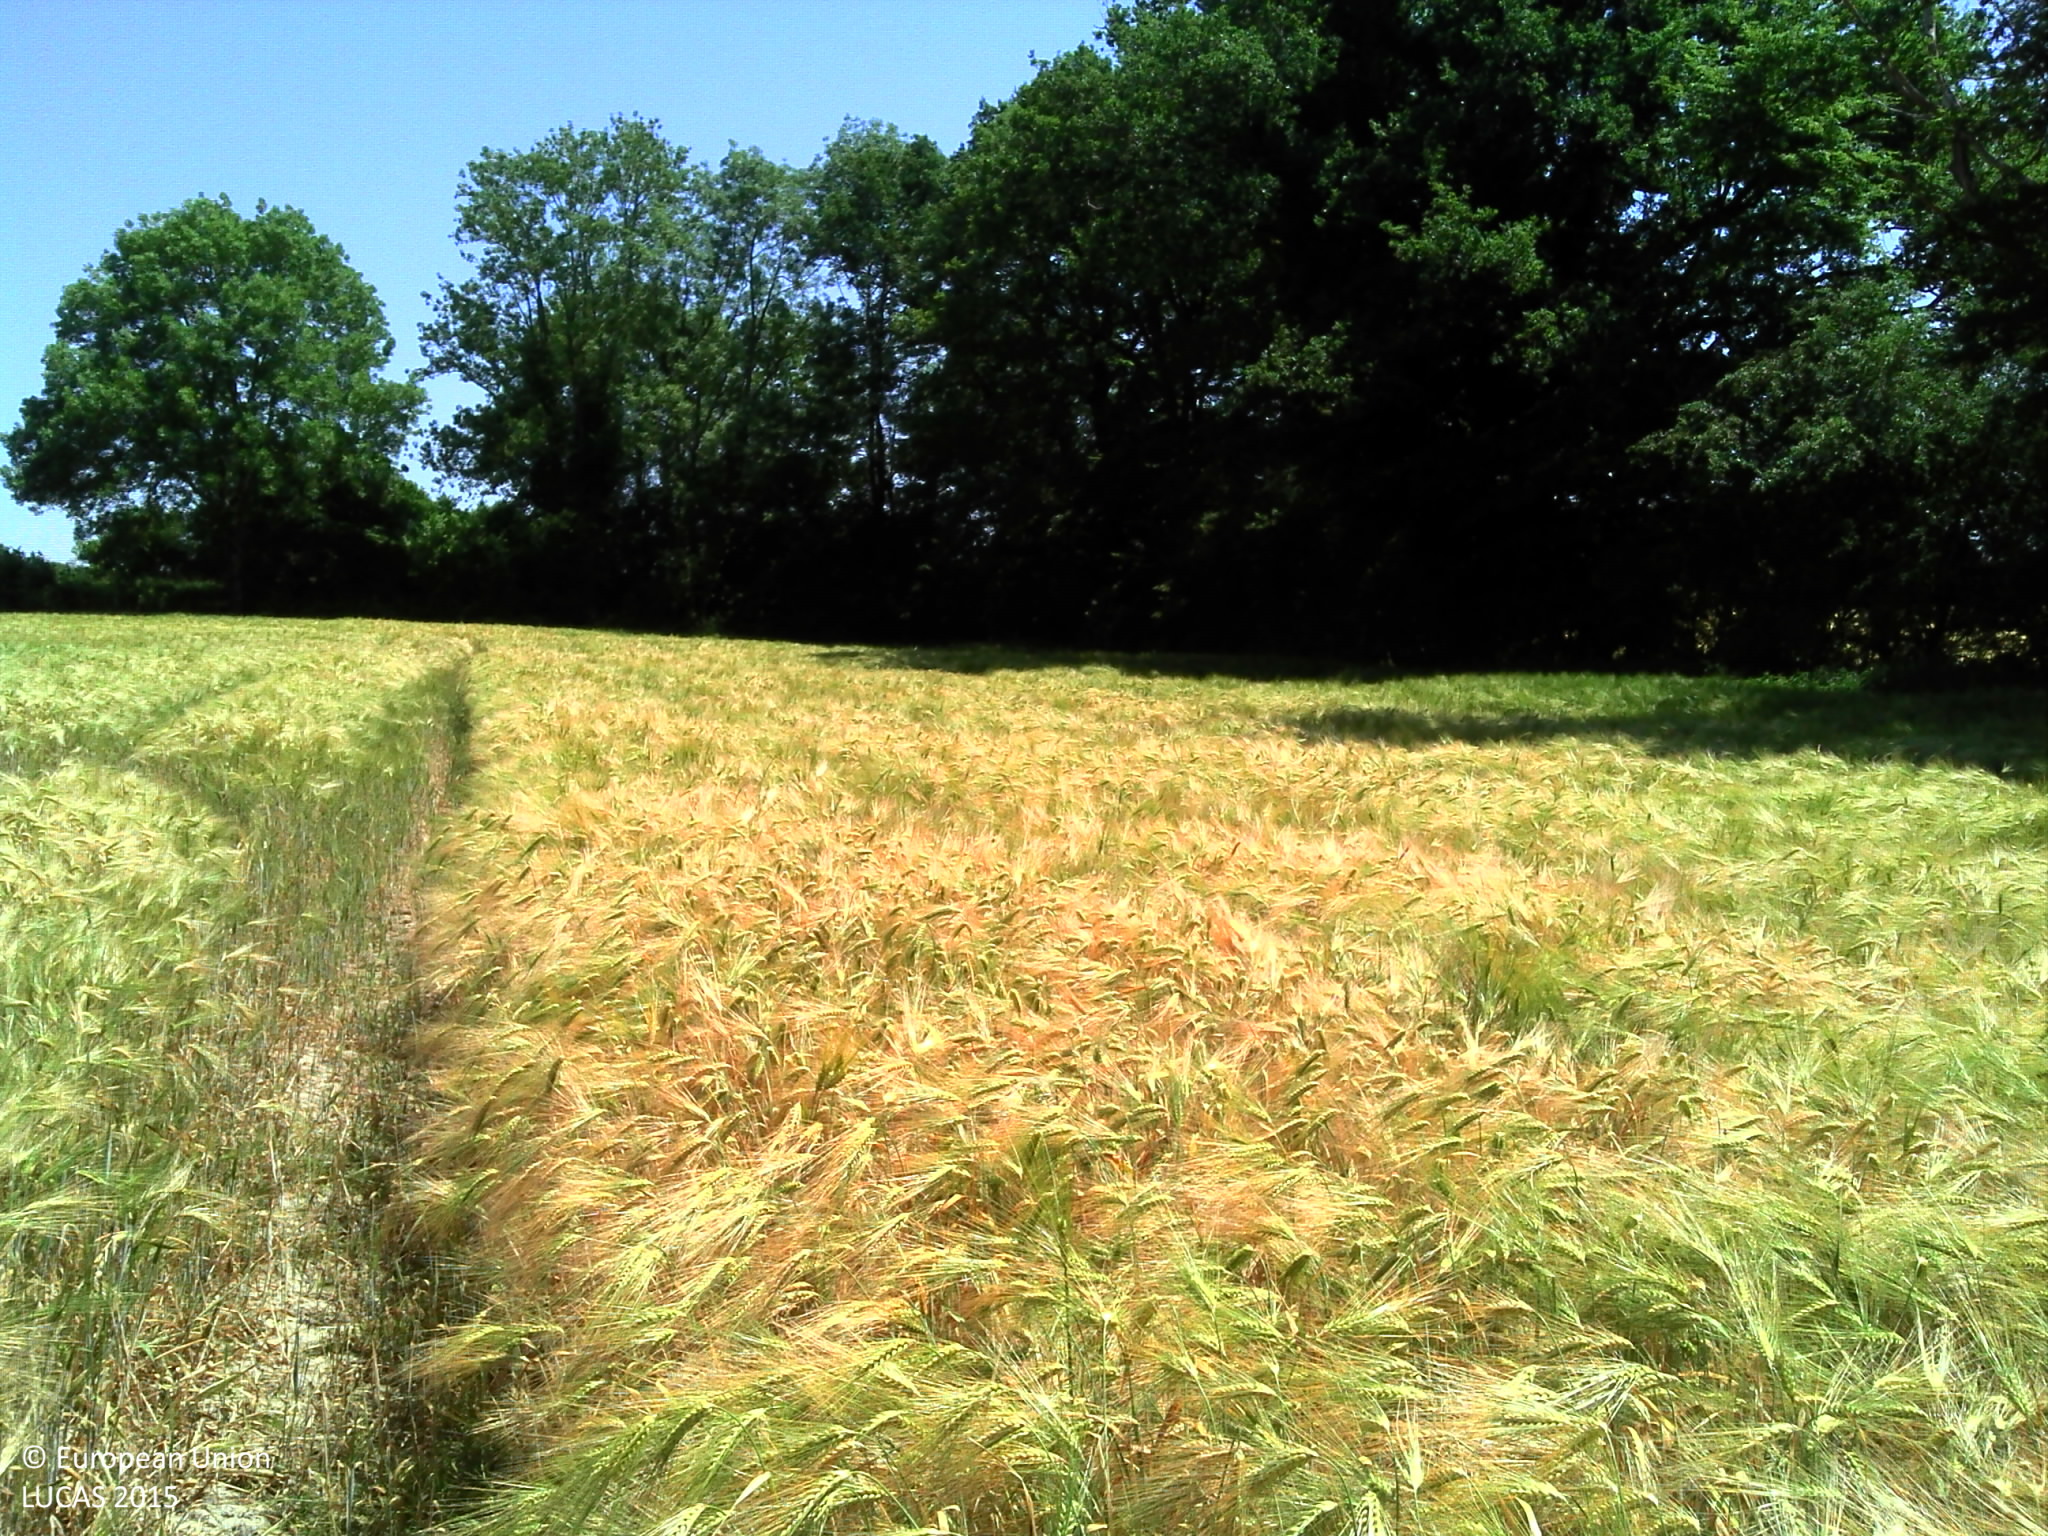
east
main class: Cropland
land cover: Barley
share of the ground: > 75 %
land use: Agriculture (excluding fallow land and kitchen gardens)
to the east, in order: Barley; Grass margins; Broadleaved woodland; Fences; Ditches and canals; Fences; Grass margins; Paved roads, cycling and walking lanes; Grass margins; Ditches and canals; Electric lines; Broadleaved woodland; Fences; Grassland without tree/shrub cover; Fences; Ditches and canals; Grassland without tree/shrub cover
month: June
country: FR
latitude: 46.8955
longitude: 2.9473
